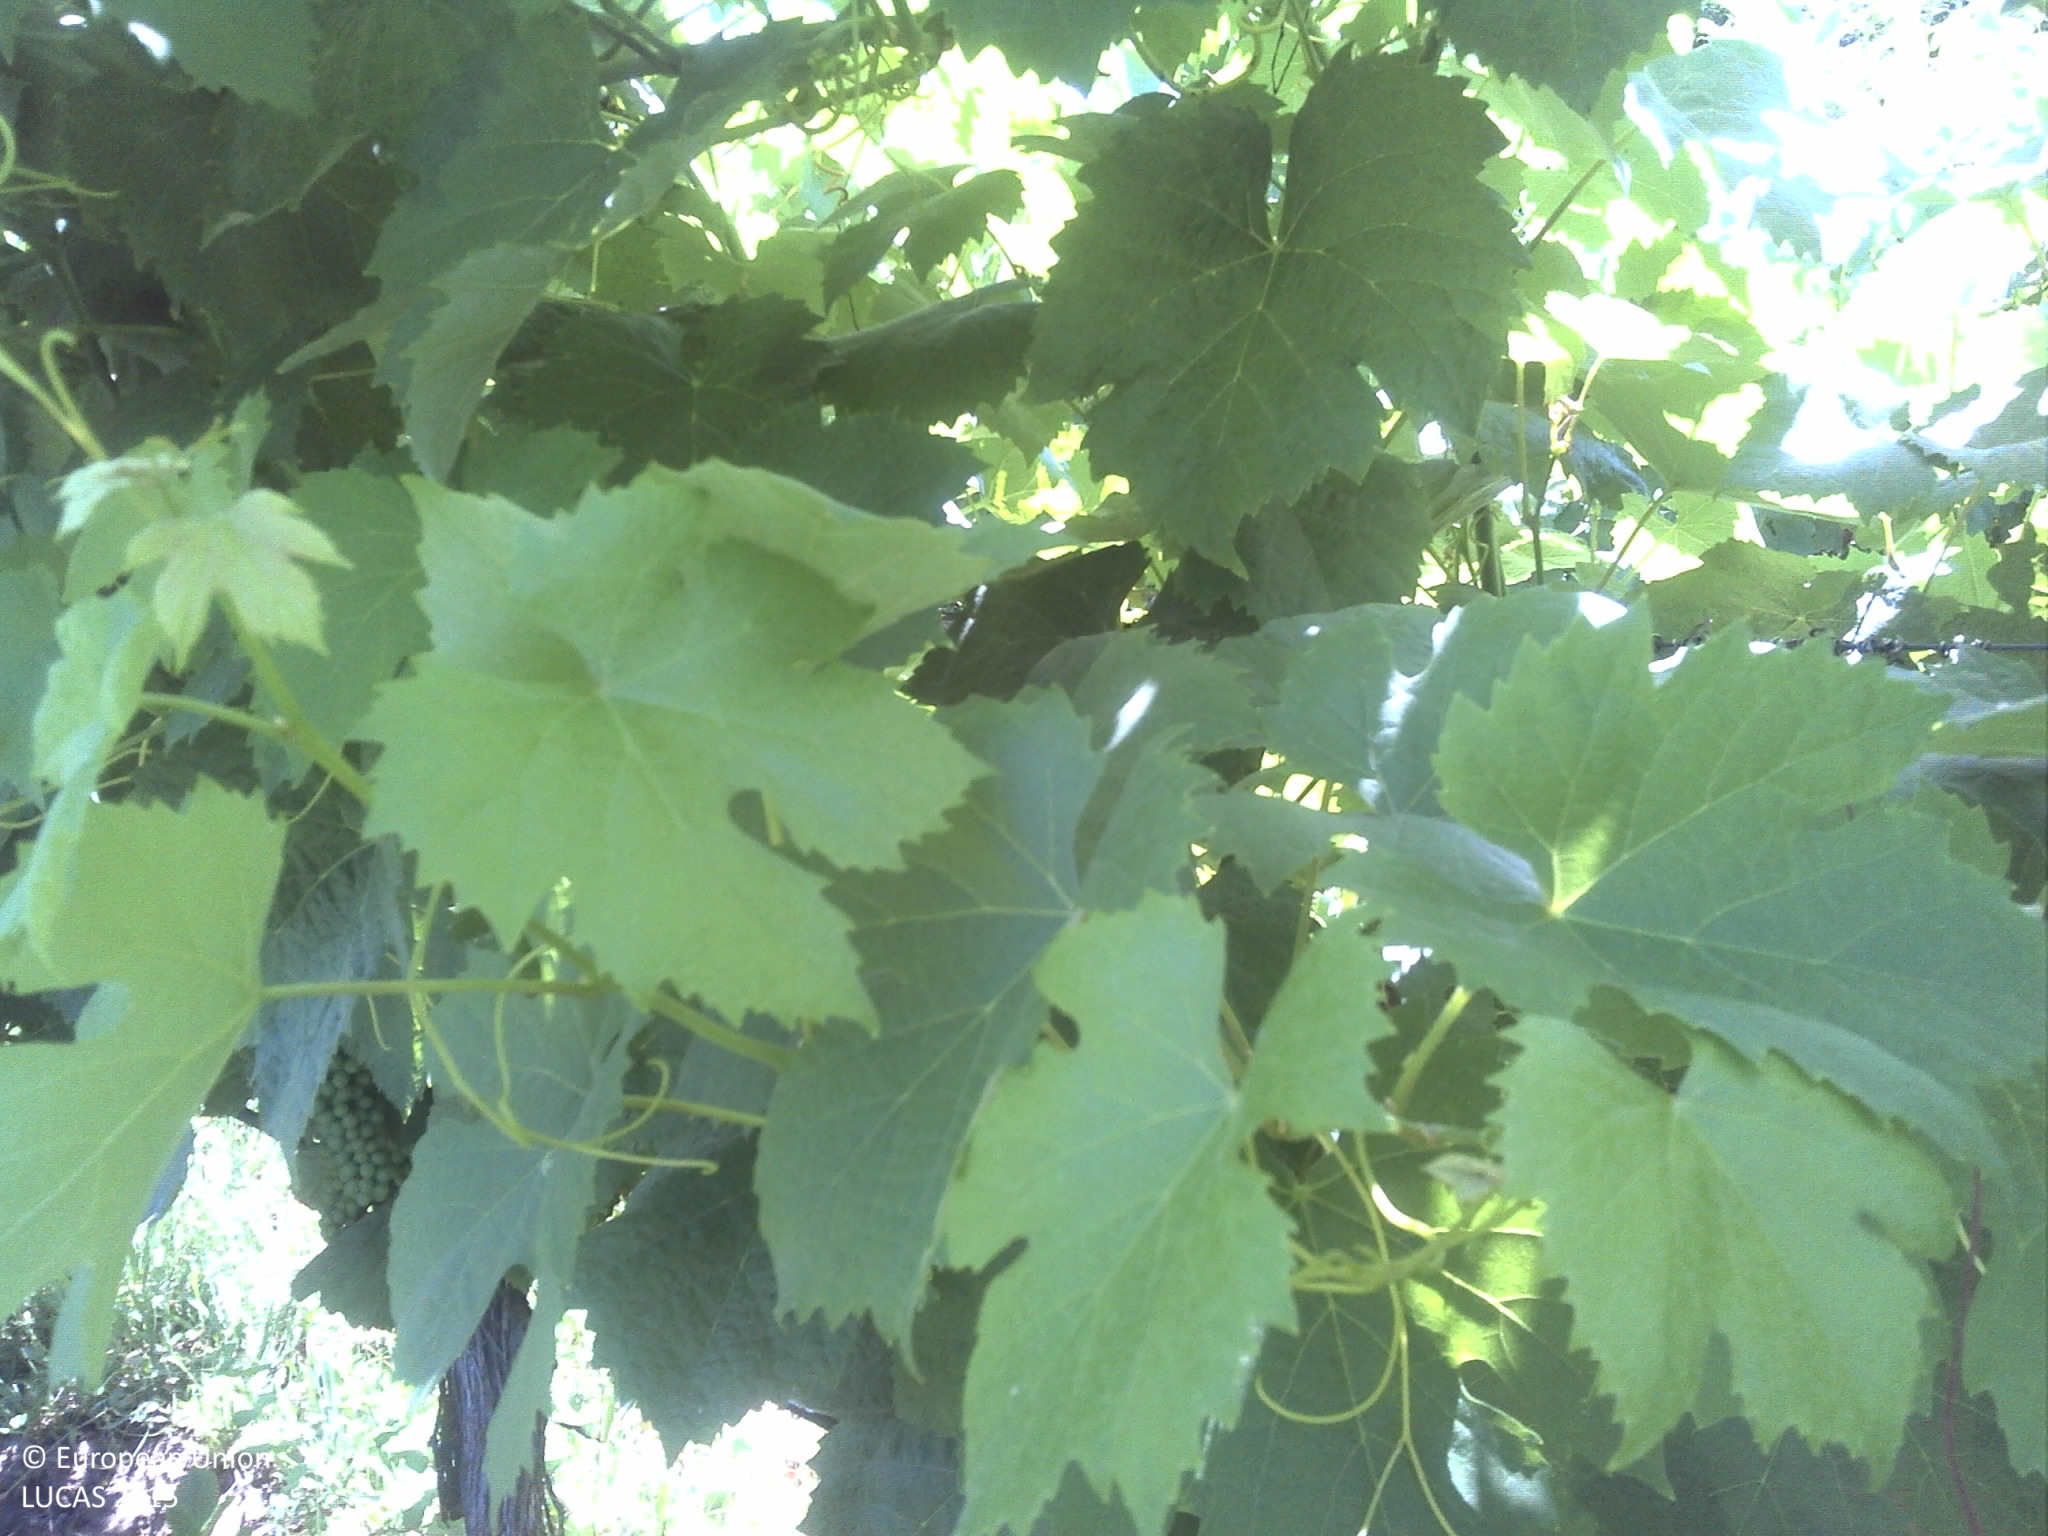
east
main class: Cropland
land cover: Vineyards
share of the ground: 25 - 50 %
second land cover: Grassland without tree/shrub cover
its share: > 75 %
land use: Agriculture (excluding fallow land and kitchen gardens)
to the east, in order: Vineyards; Grassland without tree/shrub cover; Vineyards; Electric lines; Vineyards; Shrubland without tree cover; Vineyards; Electric lines; Vineyards; Dry stone walls; Paved roads, cycling and walking lanes; Electric lines; Dry stone walls; Vineyards; Artificial constructions in urban areas; Broadleaved woodland
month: June
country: PT
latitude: 41.3781
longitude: -7.9905
